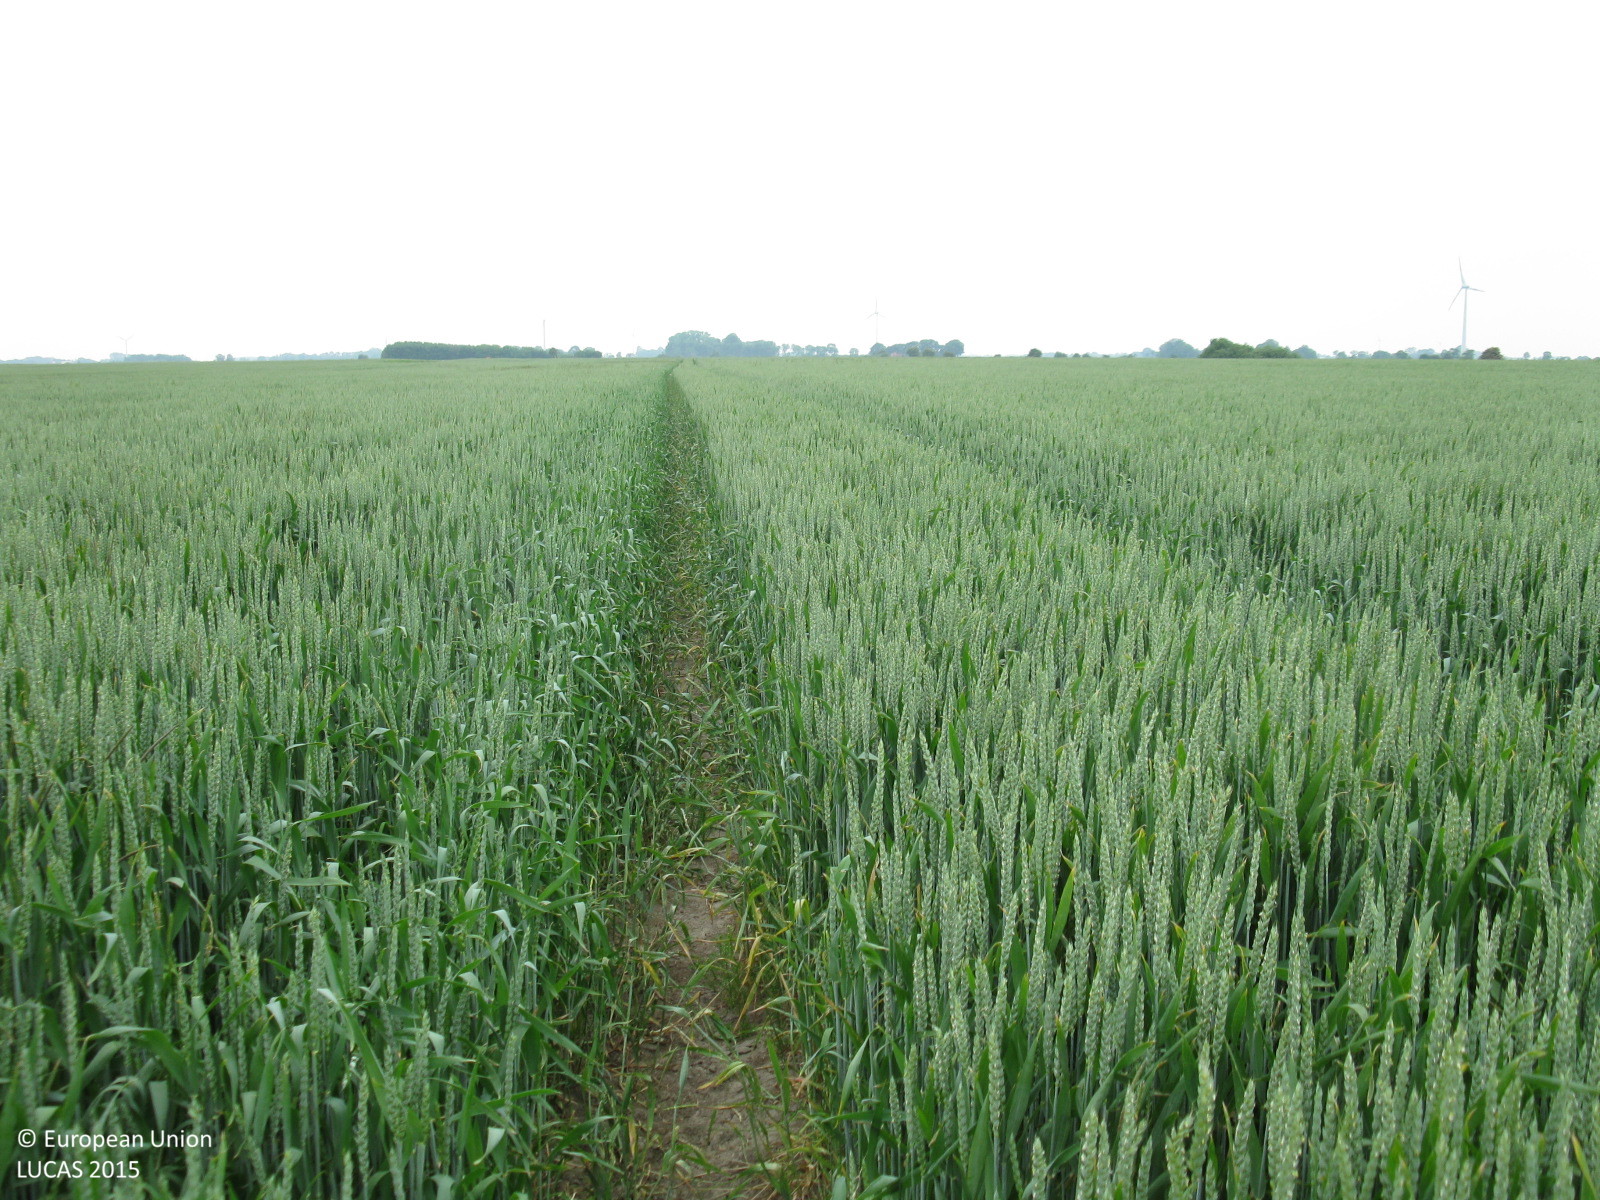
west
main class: Cropland
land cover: Common wheat
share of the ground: > 75 %
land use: Agriculture (excluding fallow land and kitchen gardens)
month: June
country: DE
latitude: 53.4971
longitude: 7.2722
